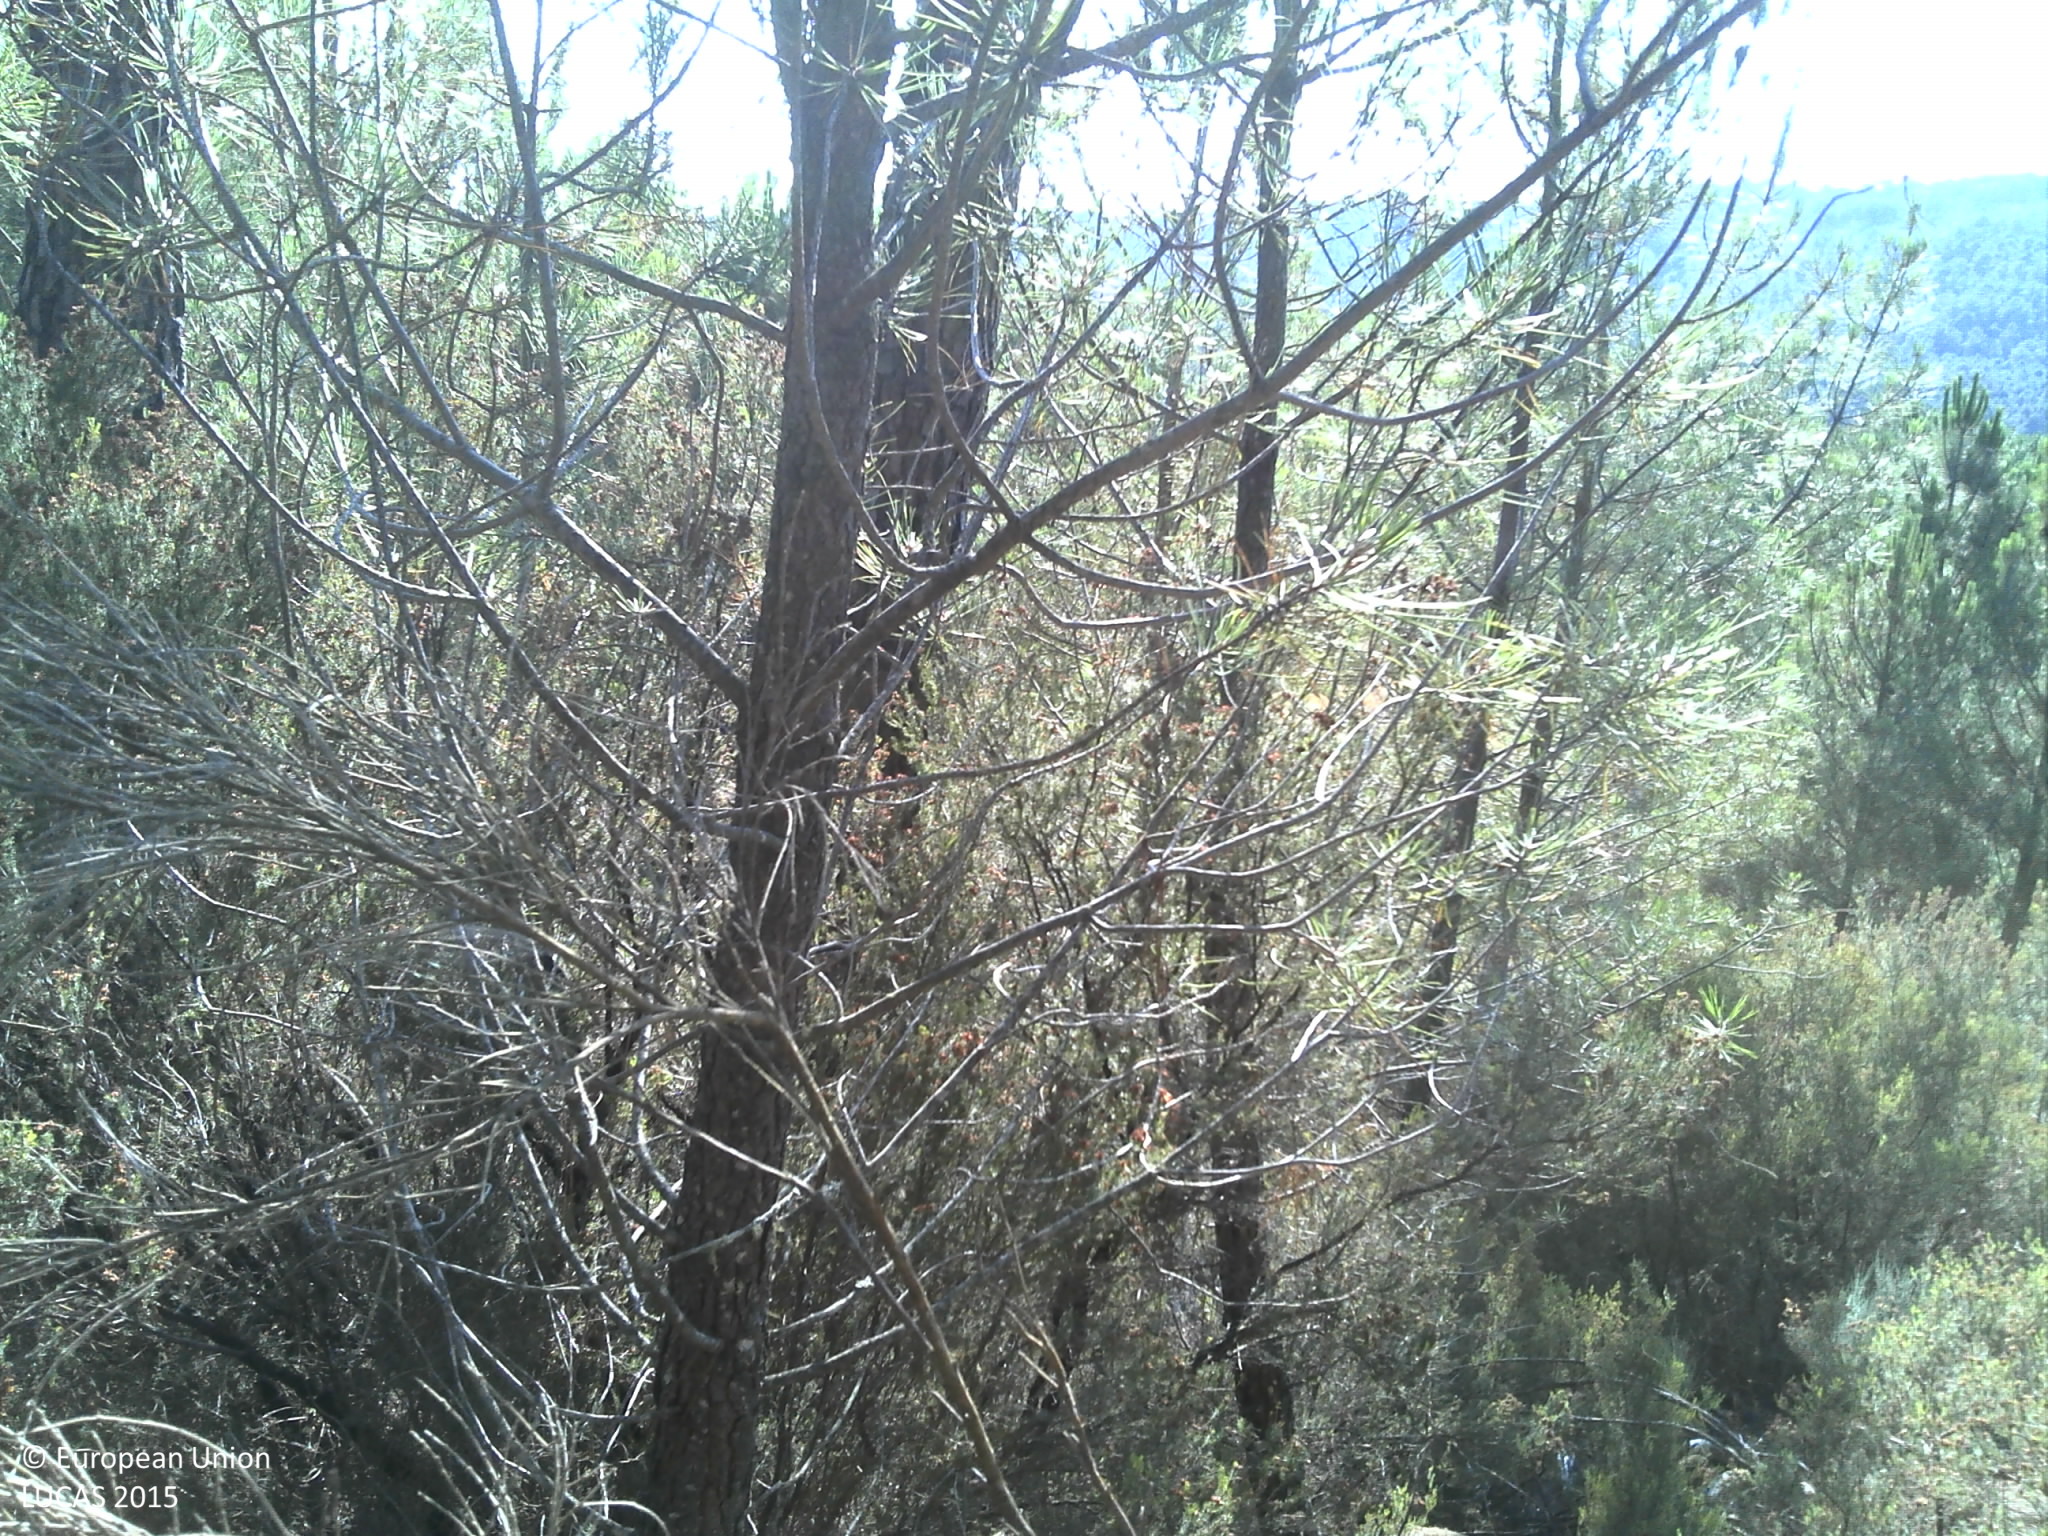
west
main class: Woodland
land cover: Pine dominated coniferous woodland
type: coniferous forest of the mediterranean region
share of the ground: 10 - 25 %
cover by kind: shrubs 80 %, coniferous forest trees 15 %, consolidated bare surface 5 %
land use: Forestry
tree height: > 5 m
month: July
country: PT
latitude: 40.7753
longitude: -7.4484
